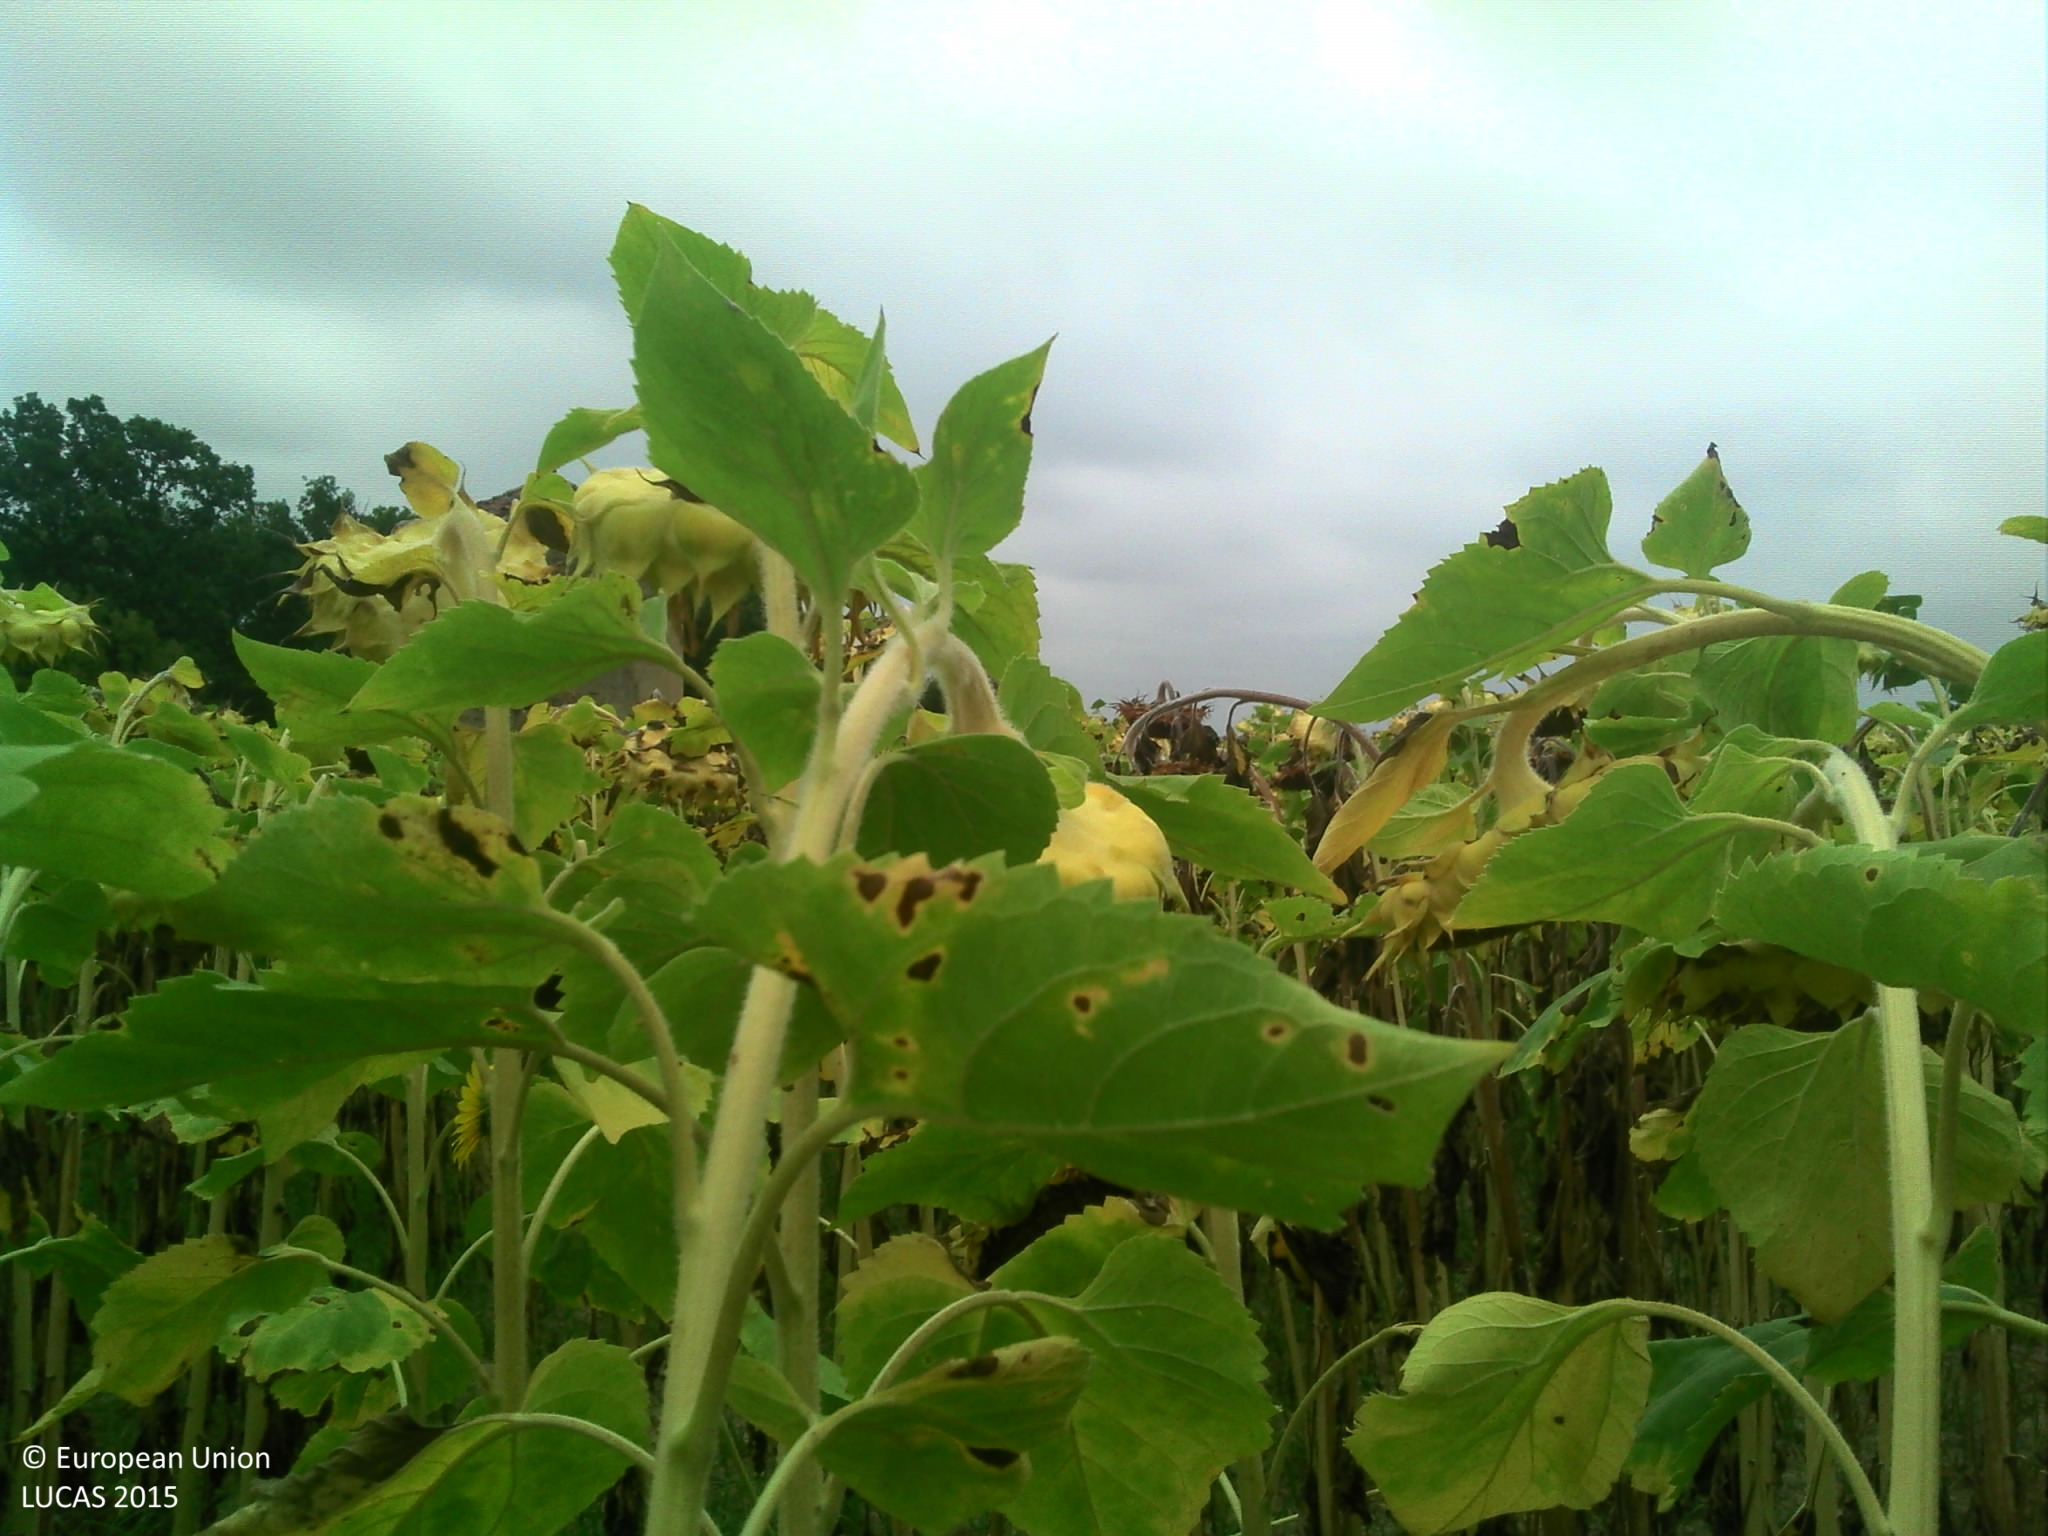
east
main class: Cropland
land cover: Sunflower
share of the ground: > 75 %
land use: Agriculture (excluding fallow land and kitchen gardens)
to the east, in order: Sunflower; Grassland without tree/shrub cover; Broadleaved woodland; Ditches and canals; Temporary grasslands
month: August
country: FR
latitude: 44.0707
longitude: 1.2466
